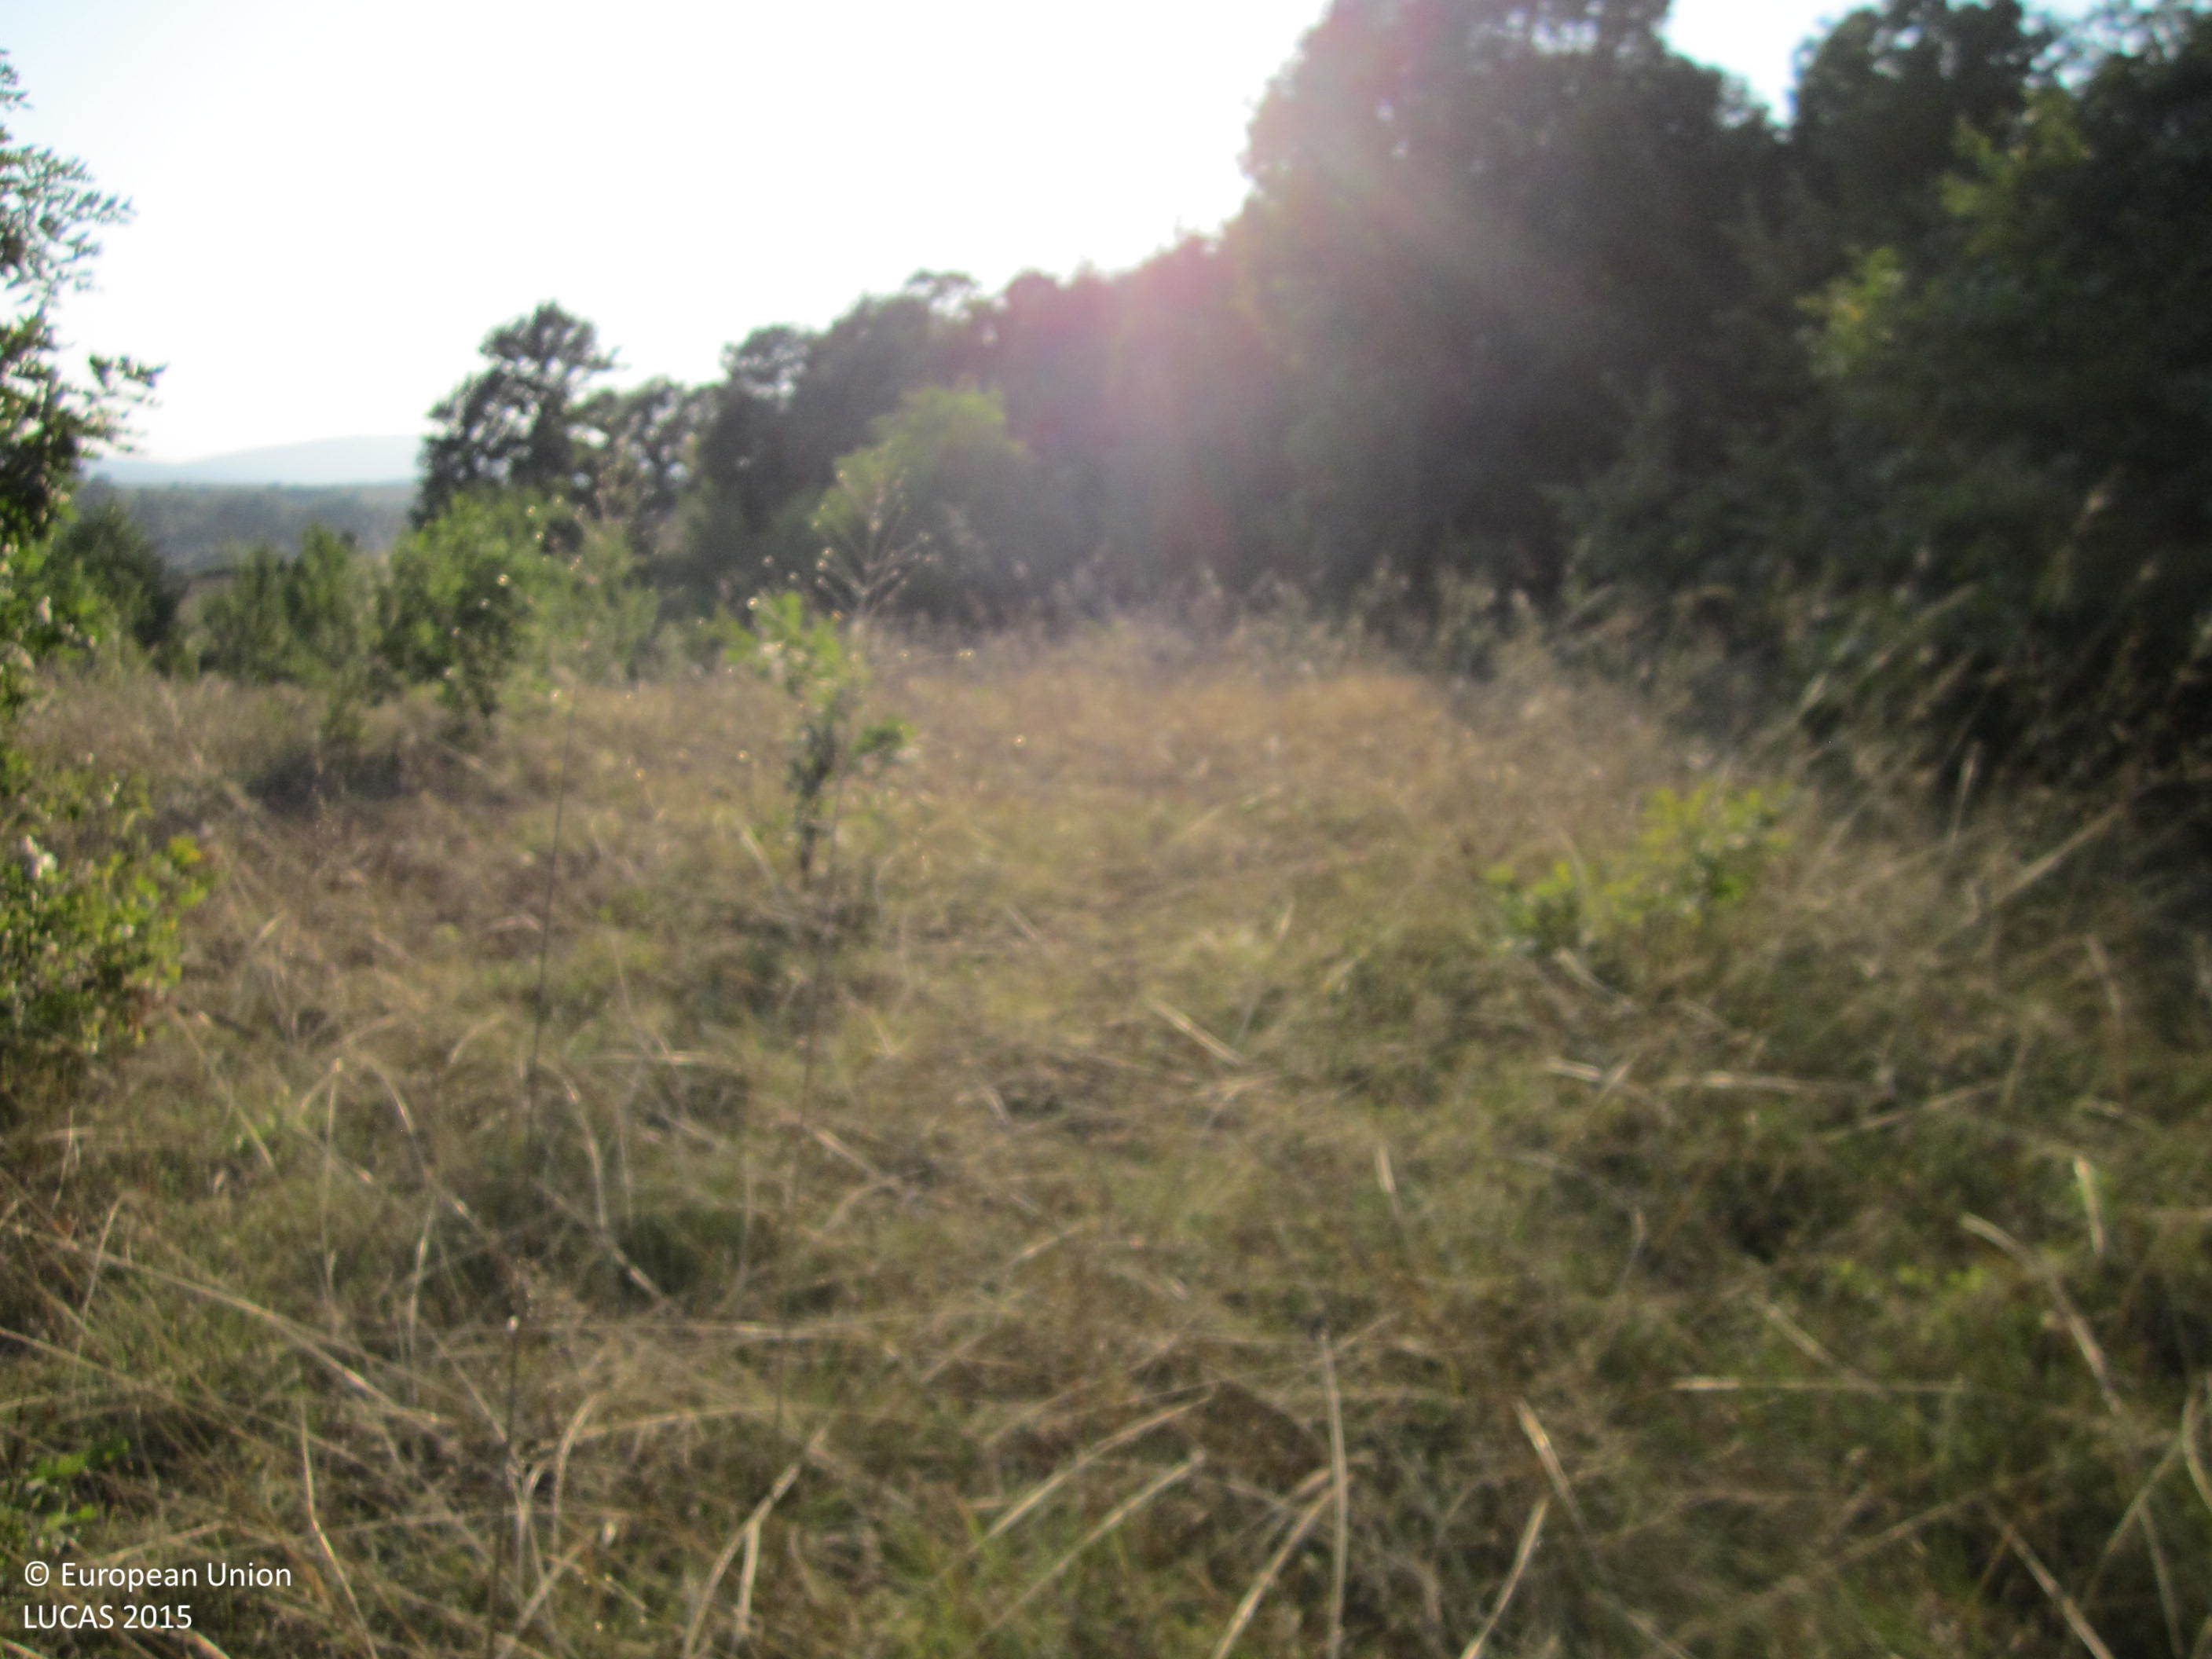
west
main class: Woodland
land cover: Broadleaved woodland
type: mesophytic deciduous forest
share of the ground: 25 - 50 %
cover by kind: herbaceous plants 60 %, broadleaved forest trees 35 %, shrubs 5 %
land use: Semi-natural and natural areas not in use
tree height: > 5 m
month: September
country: BG
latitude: 42.8392
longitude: 27.1312
